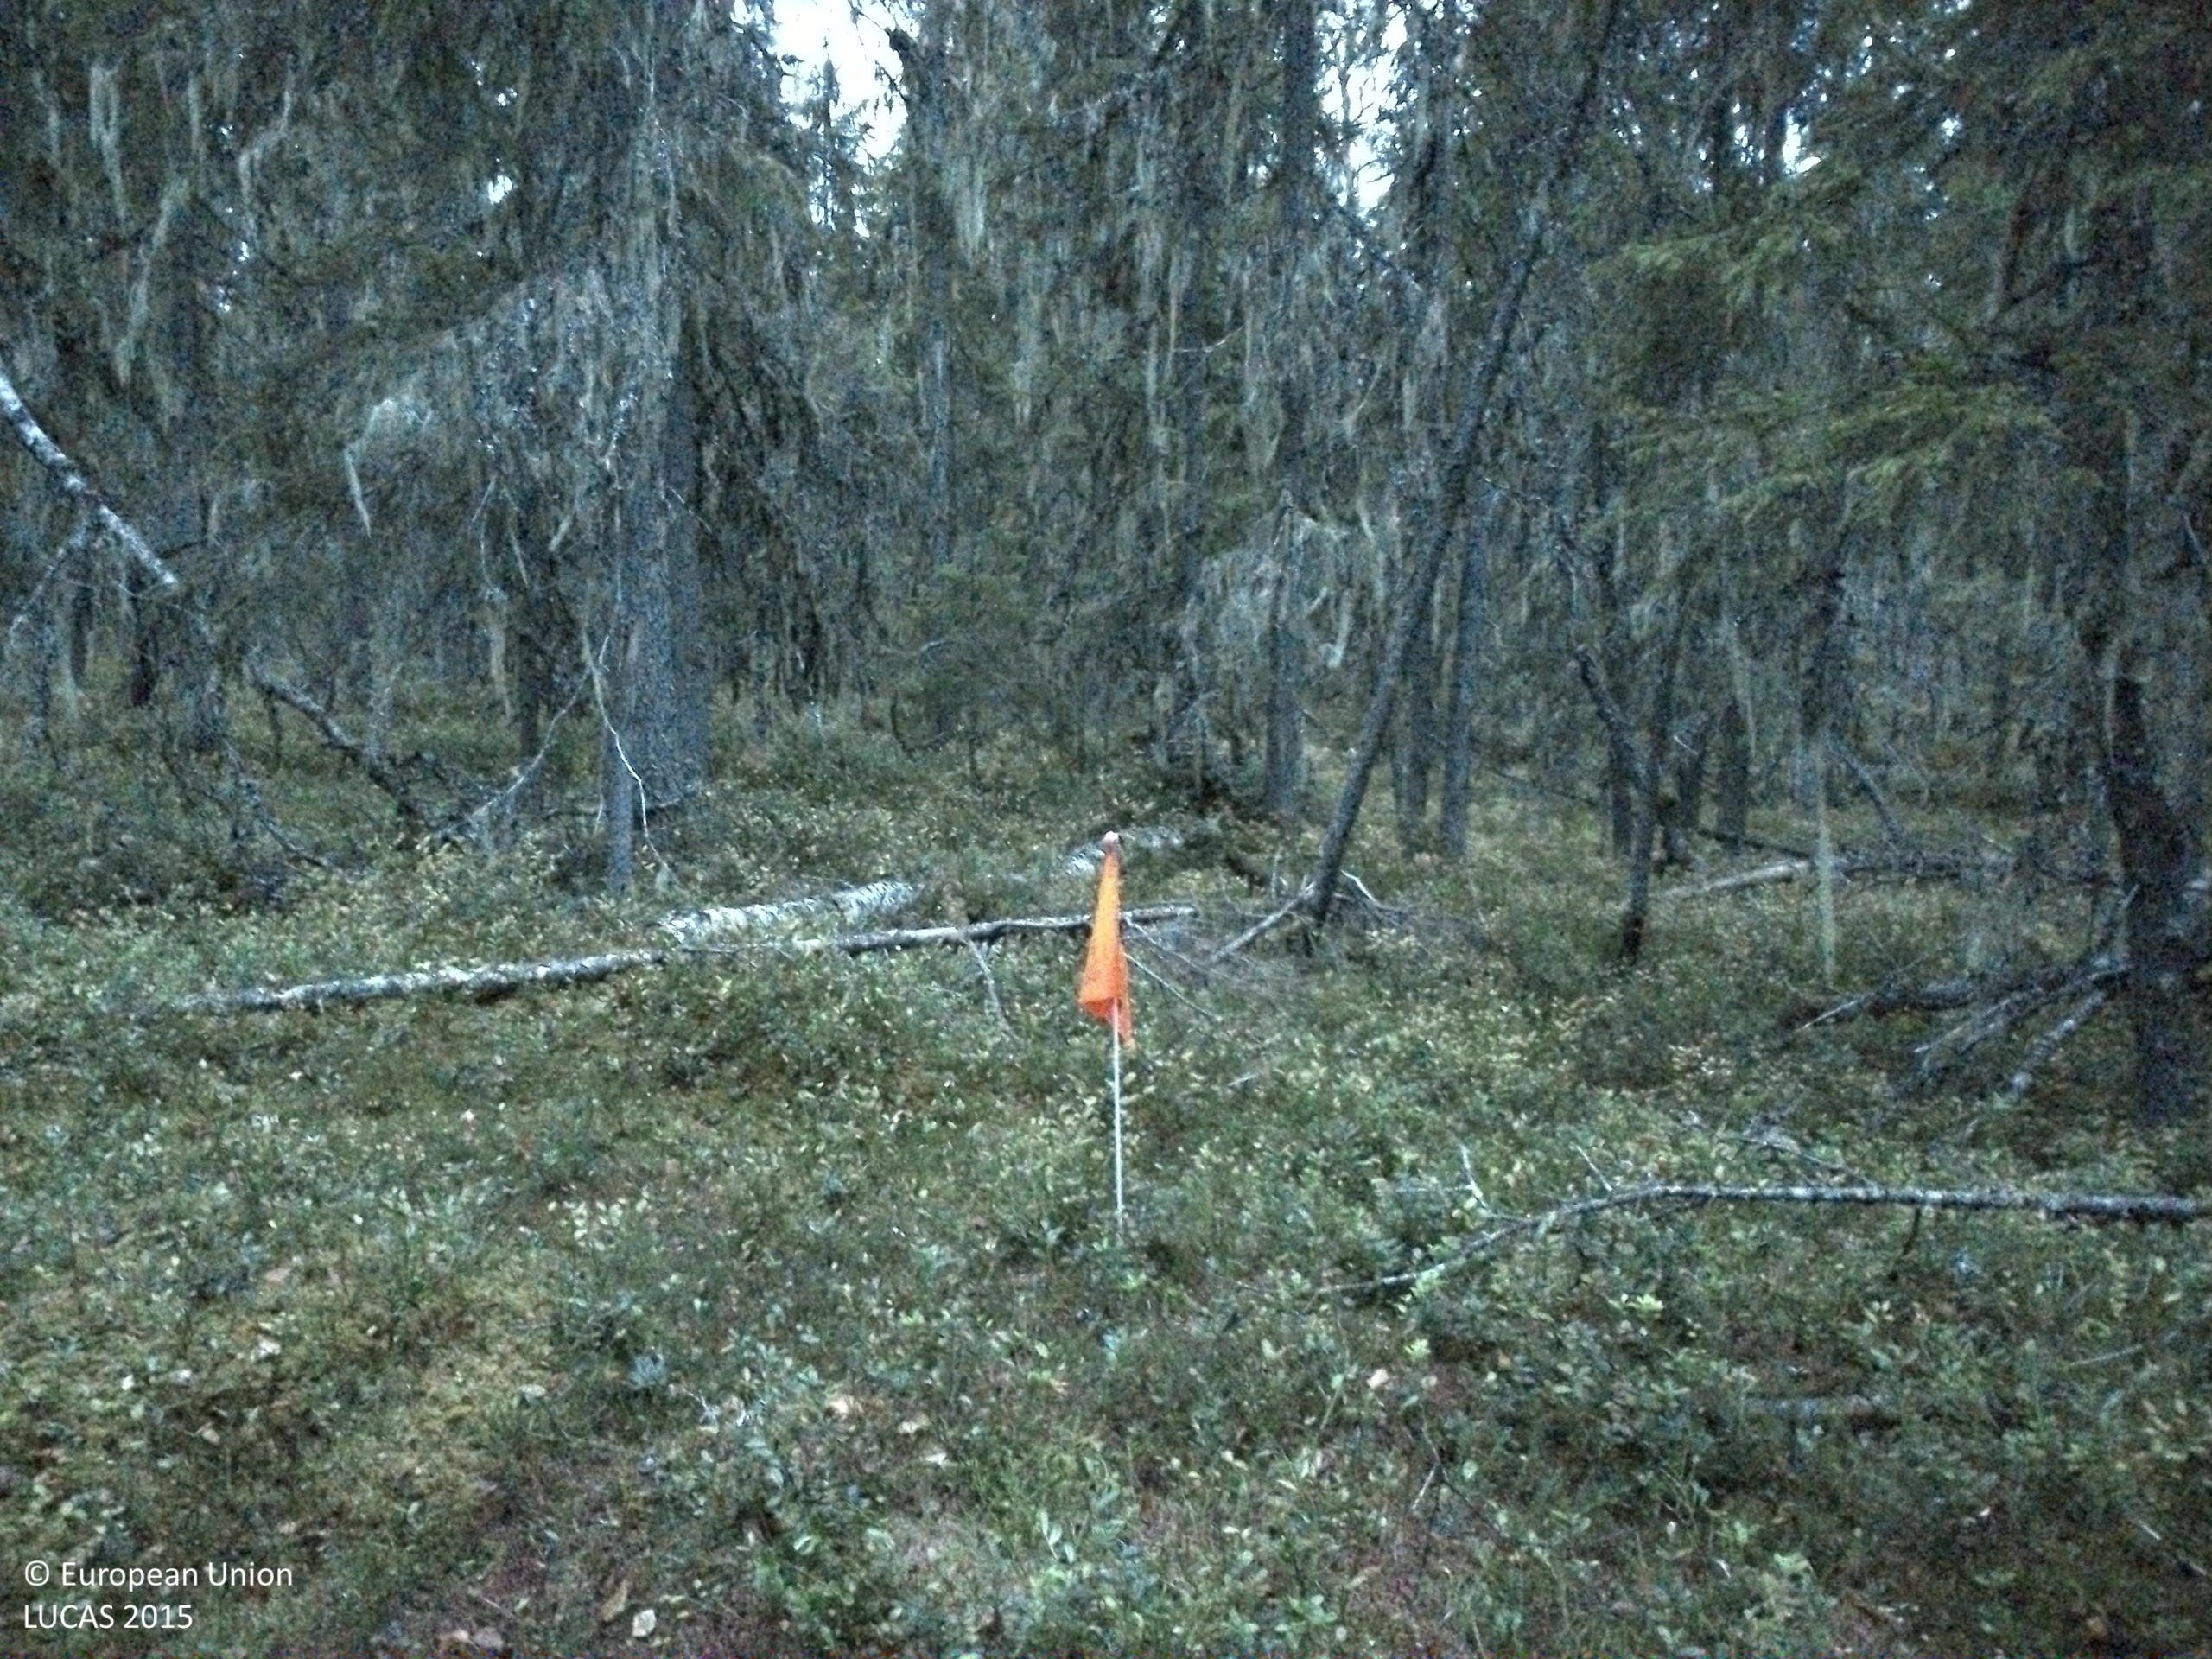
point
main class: Woodland
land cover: Spruce dominated coniferous woodland
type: boreal forest
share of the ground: 50 - 75 %
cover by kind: coniferous forest trees 65 %, shrubs 30 %, broadleaved forest trees 5 %
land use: Forestry
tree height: > 5 m
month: October
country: SE
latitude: 61.3943
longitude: 14.3482
